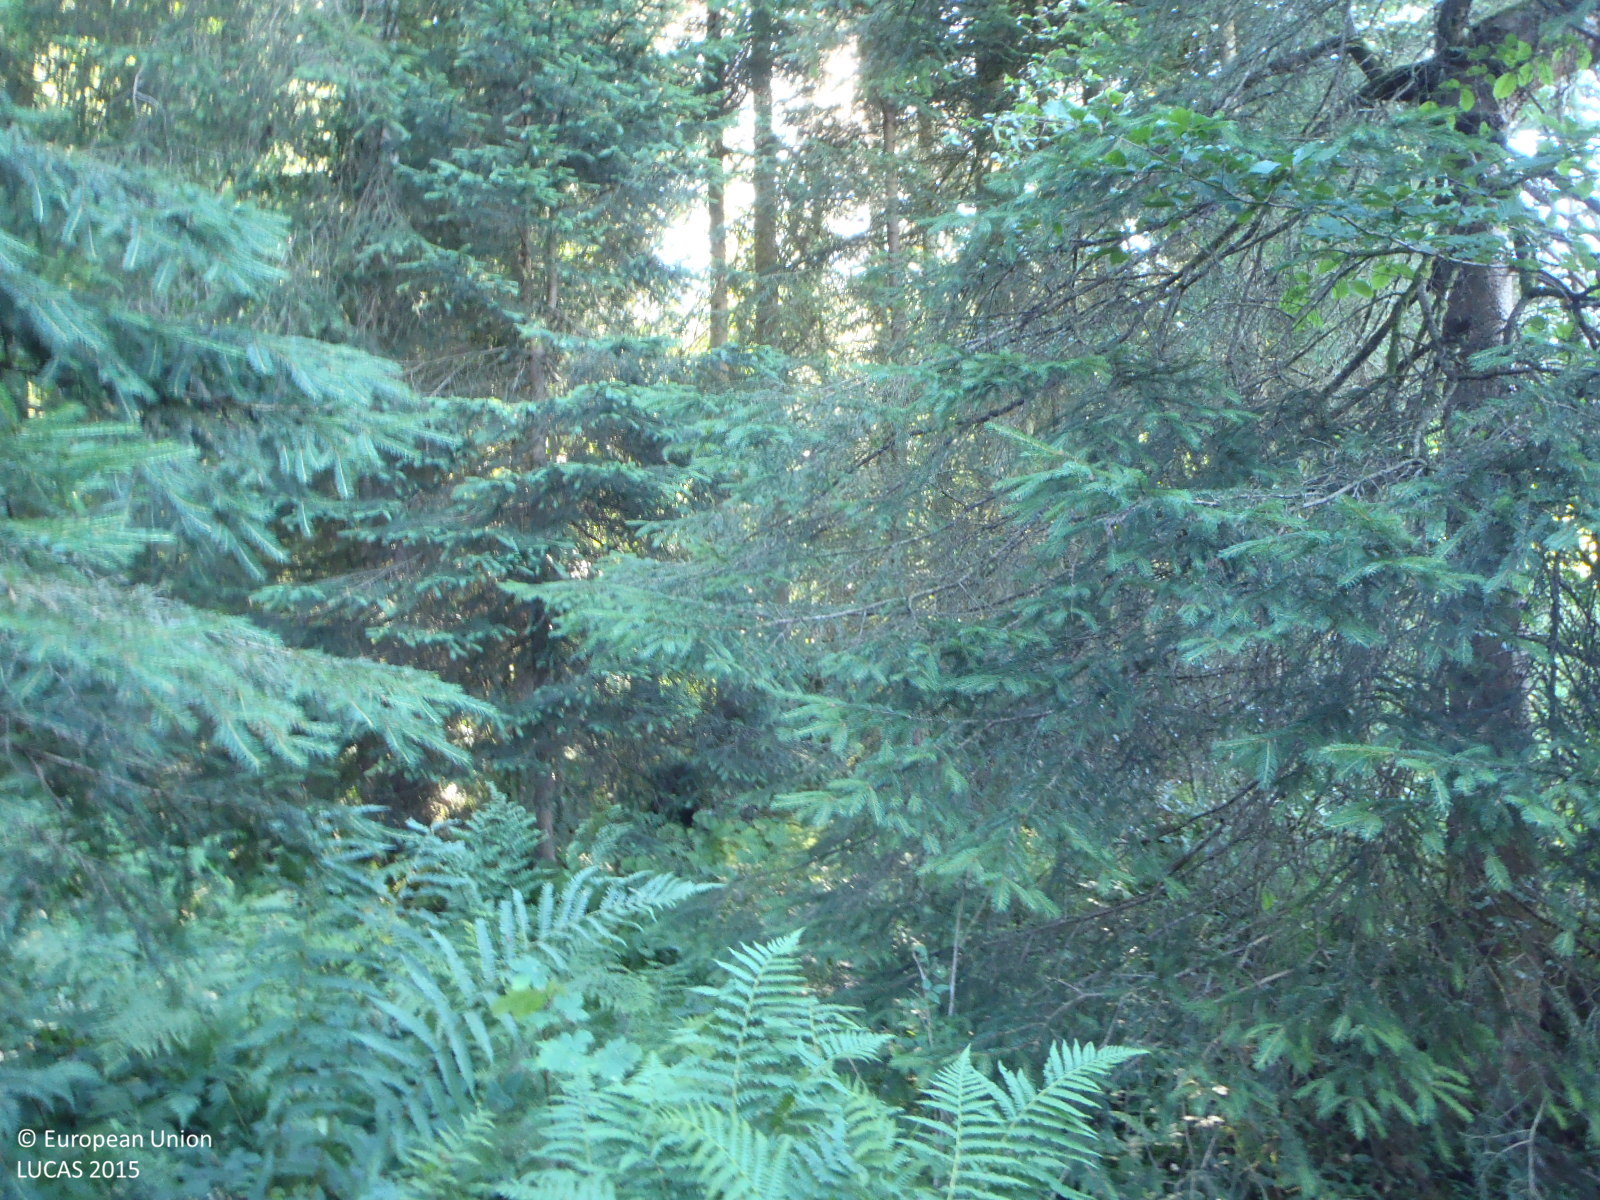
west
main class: Woodland
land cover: Other mixed woodland
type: alpine coniferous forest
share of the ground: > 75 %
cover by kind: coniferous forest trees 75 %, broadleaved forest trees 25 %
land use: Forestry
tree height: > 5 m
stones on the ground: < 10 %
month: July
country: AT
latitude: 47.4287
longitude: 12.1328
